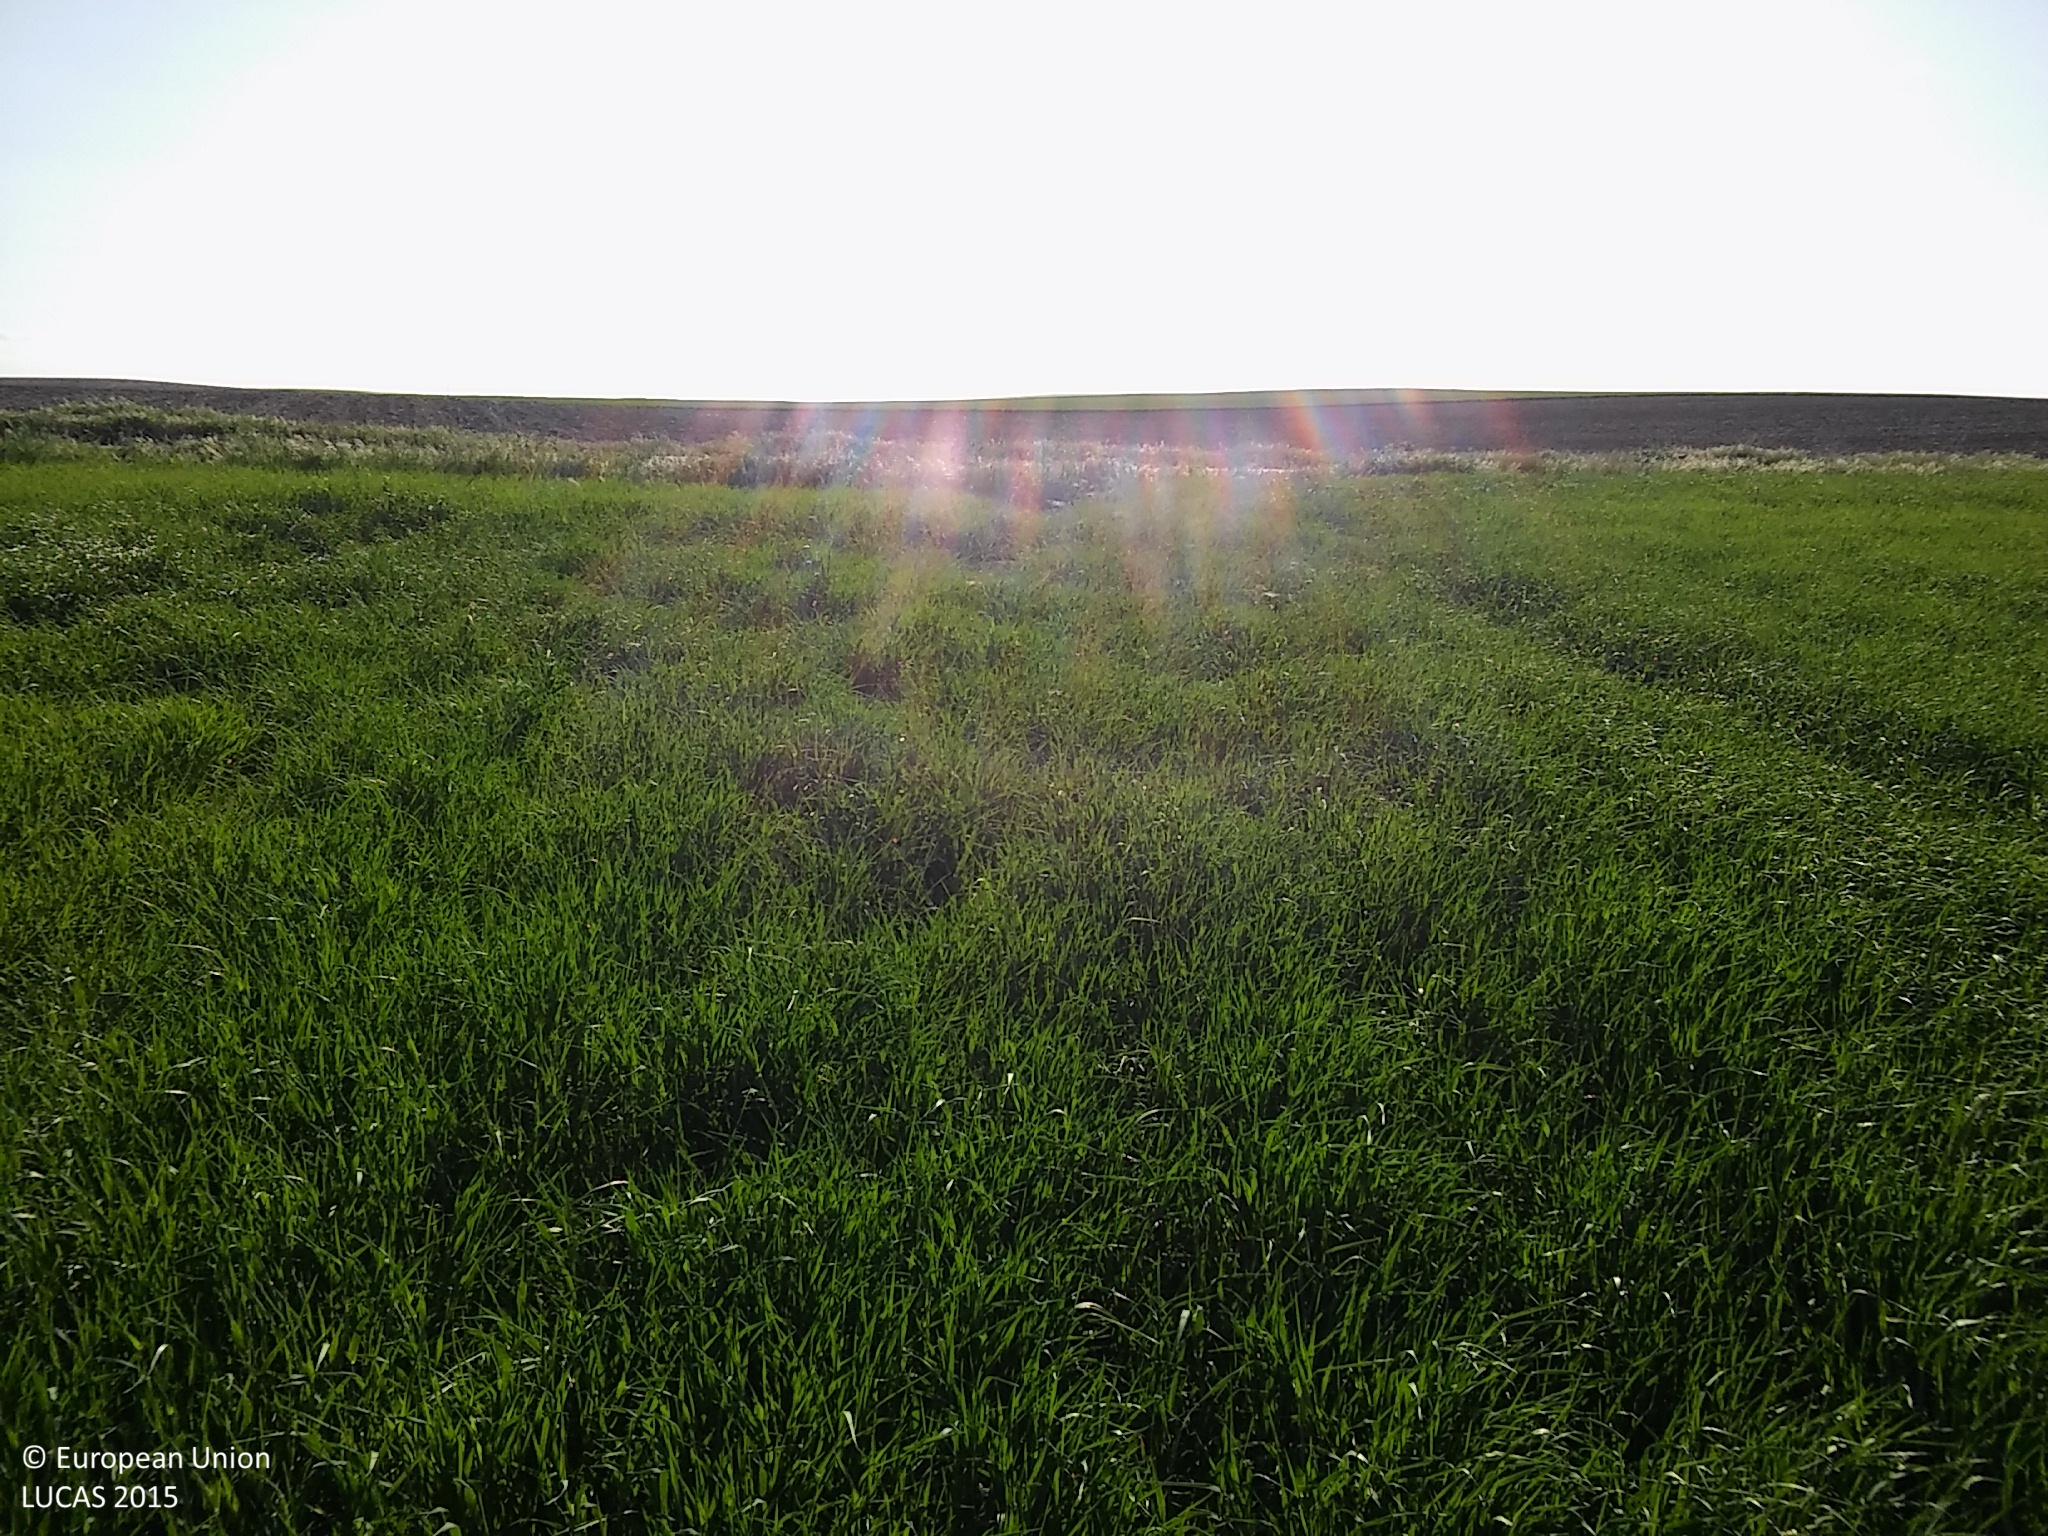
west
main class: Cropland
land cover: Barley
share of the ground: > 75 %
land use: Agriculture (excluding fallow land and kitchen gardens)
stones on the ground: 25 - 50 %
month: May
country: ES
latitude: 41.4784
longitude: -4.1040
